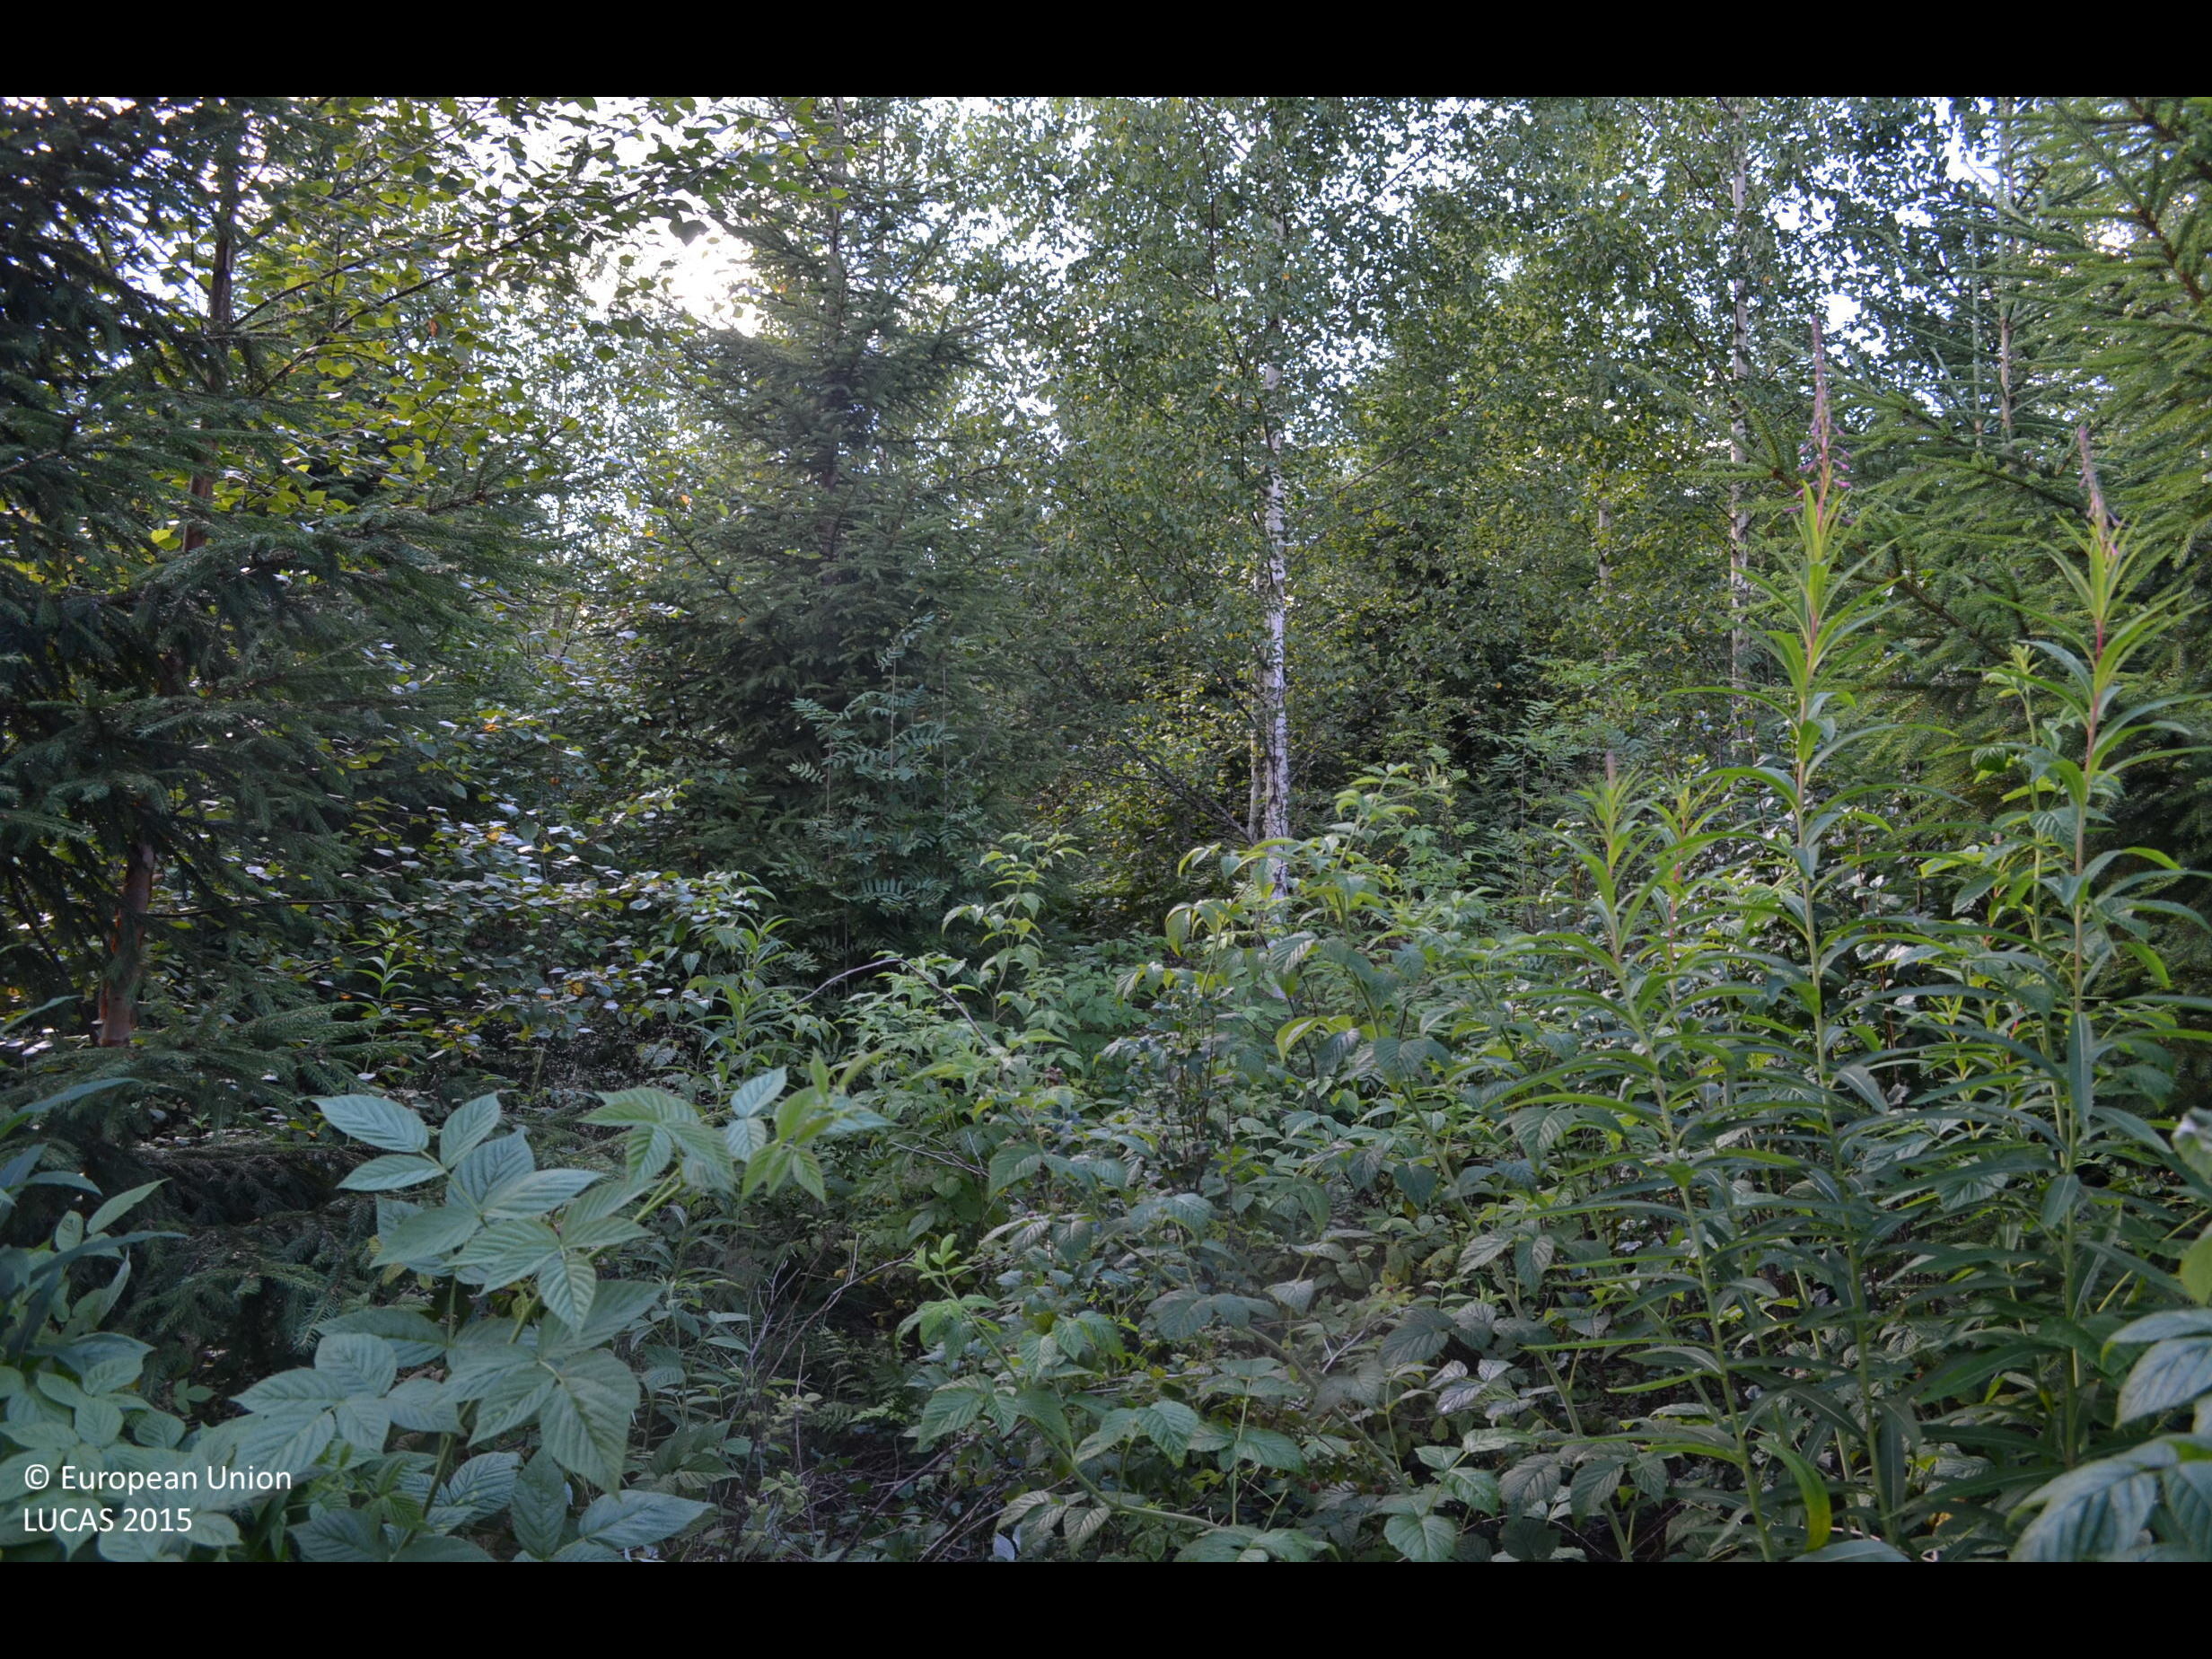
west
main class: Woodland
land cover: Spruce dominated mixed woodland
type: boreal forest
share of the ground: > 75 %
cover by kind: broadleaved forest trees 40 %, coniferous forest trees 35 %, shrubs 20 %, herbaceous plants 5 %
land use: Forestry
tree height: < 5 m
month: August
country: FI
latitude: 61.5945
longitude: 23.1312
